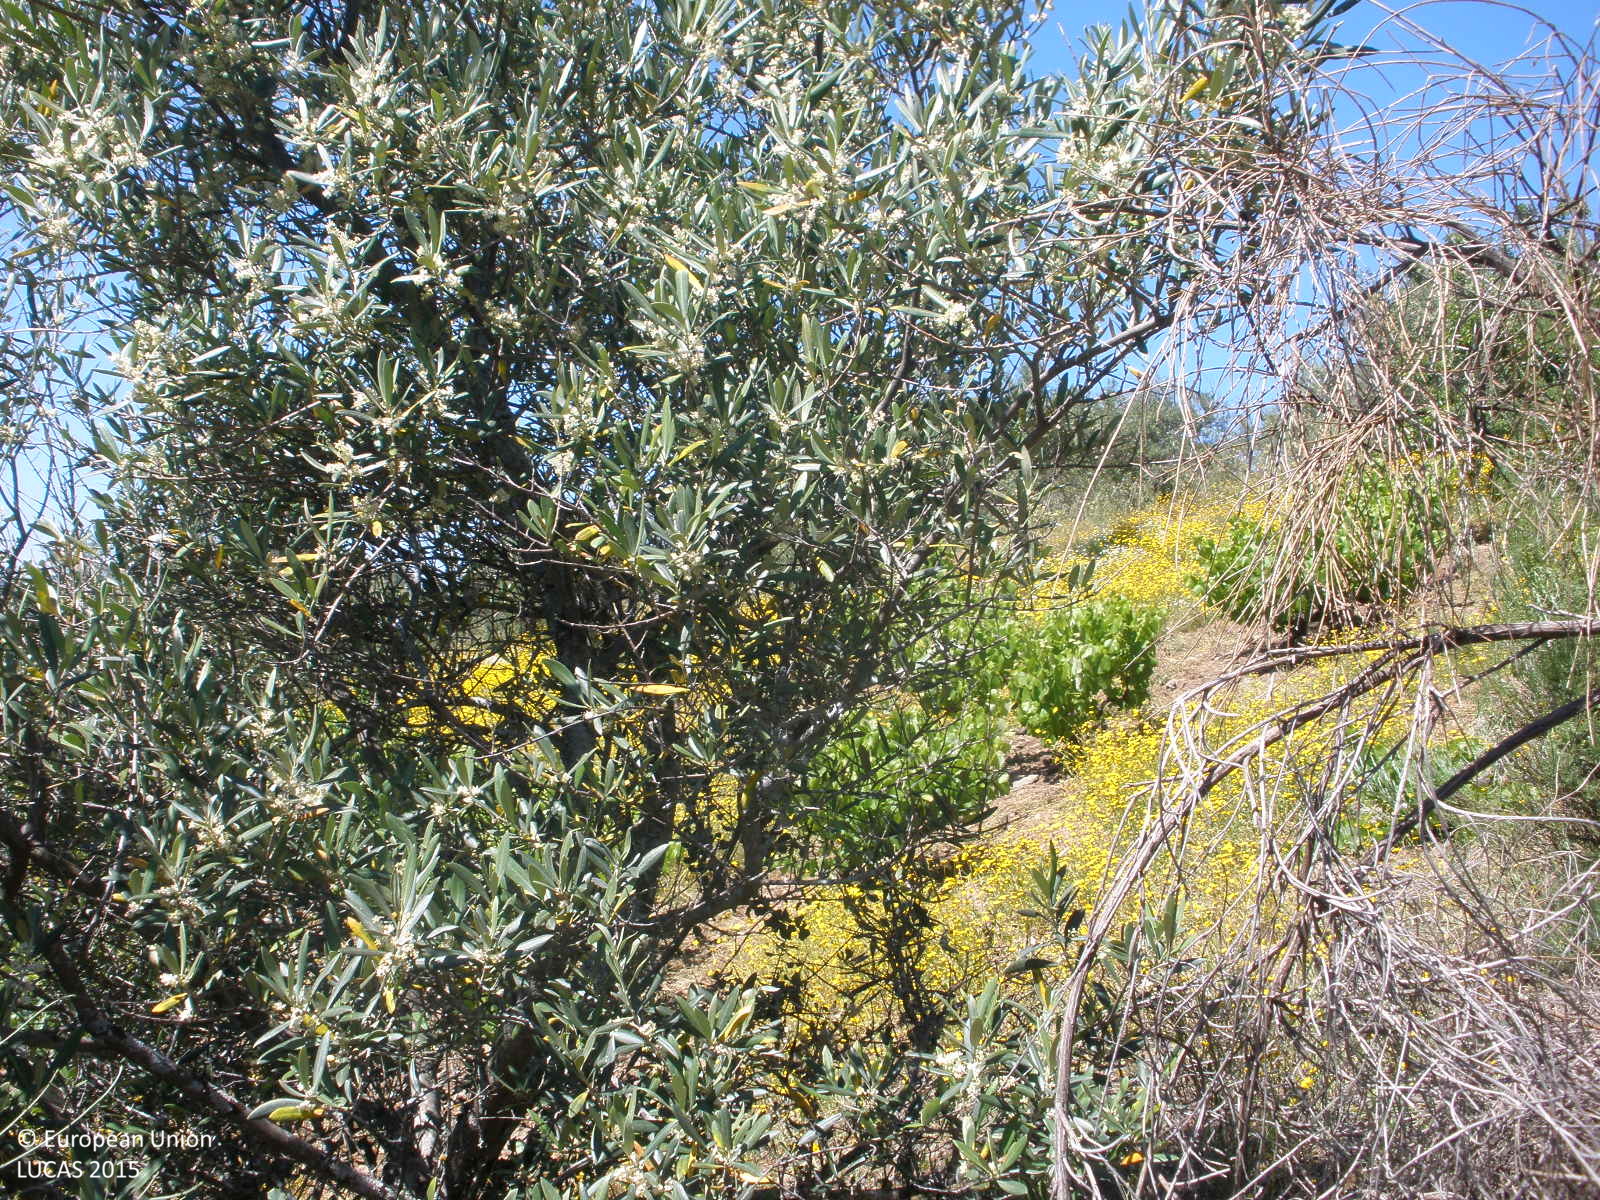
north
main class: Cropland
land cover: Olive groves
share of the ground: 50 - 75 %
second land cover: Shrubland without tree cover
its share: > 75 %
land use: Abandoned areas
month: May
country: ES
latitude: 40.3120
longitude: -6.1869
